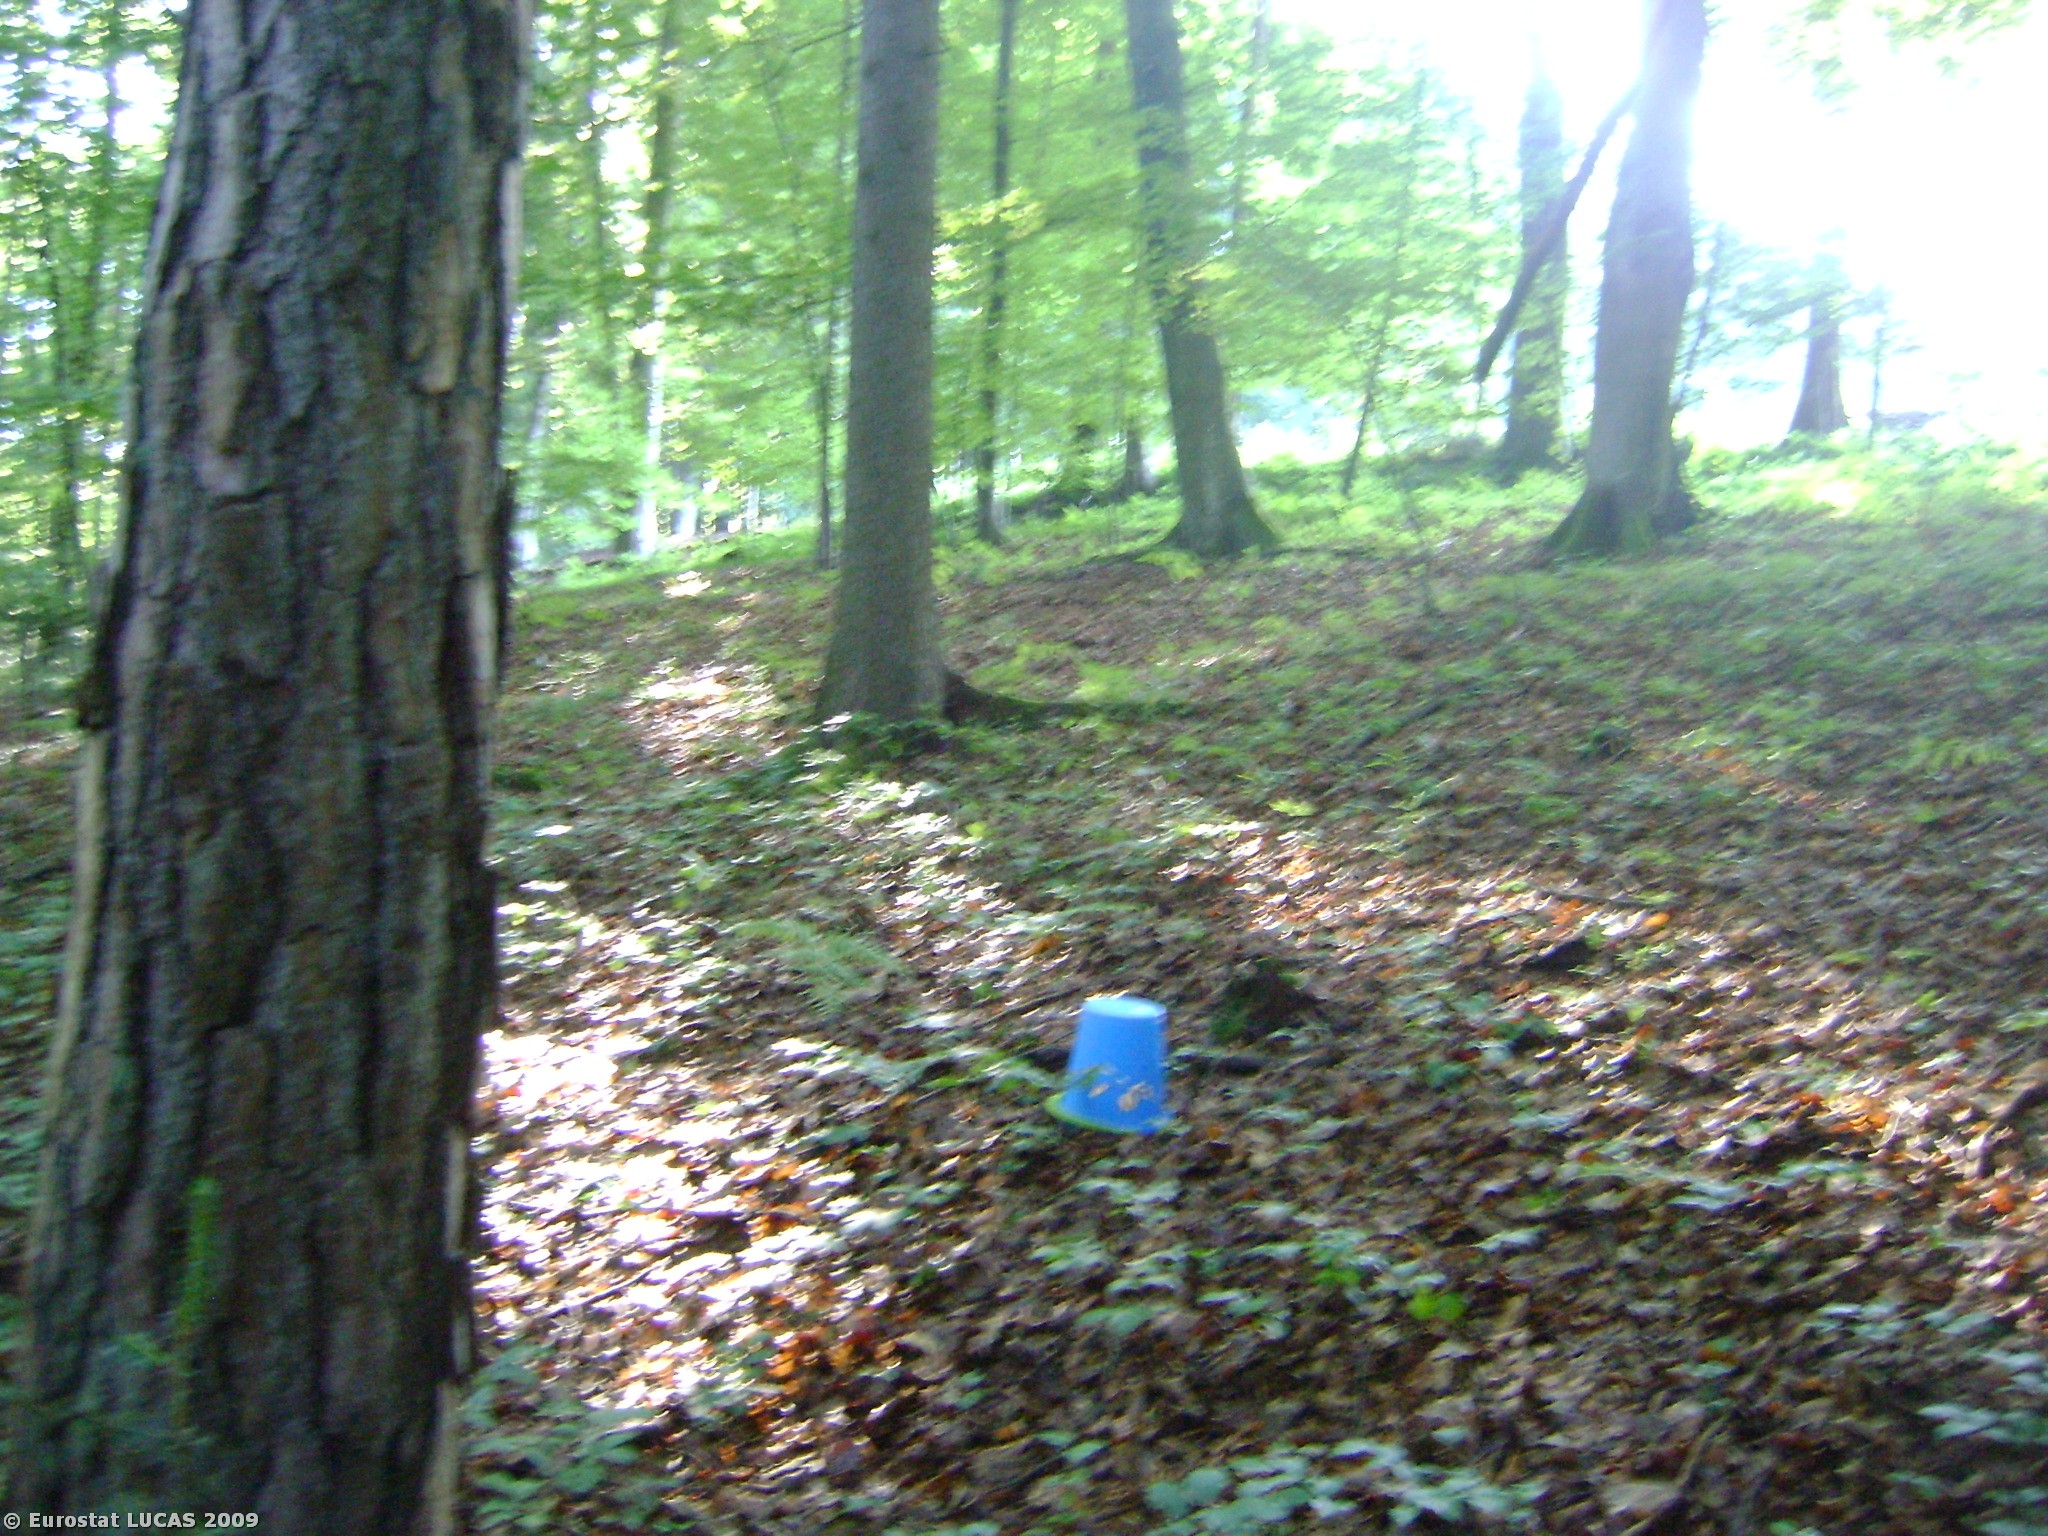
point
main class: Woodland
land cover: Broadleaved woodland
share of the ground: > 75 %
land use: Forestry
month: June
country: AT
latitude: 46.7134
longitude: 15.5327
